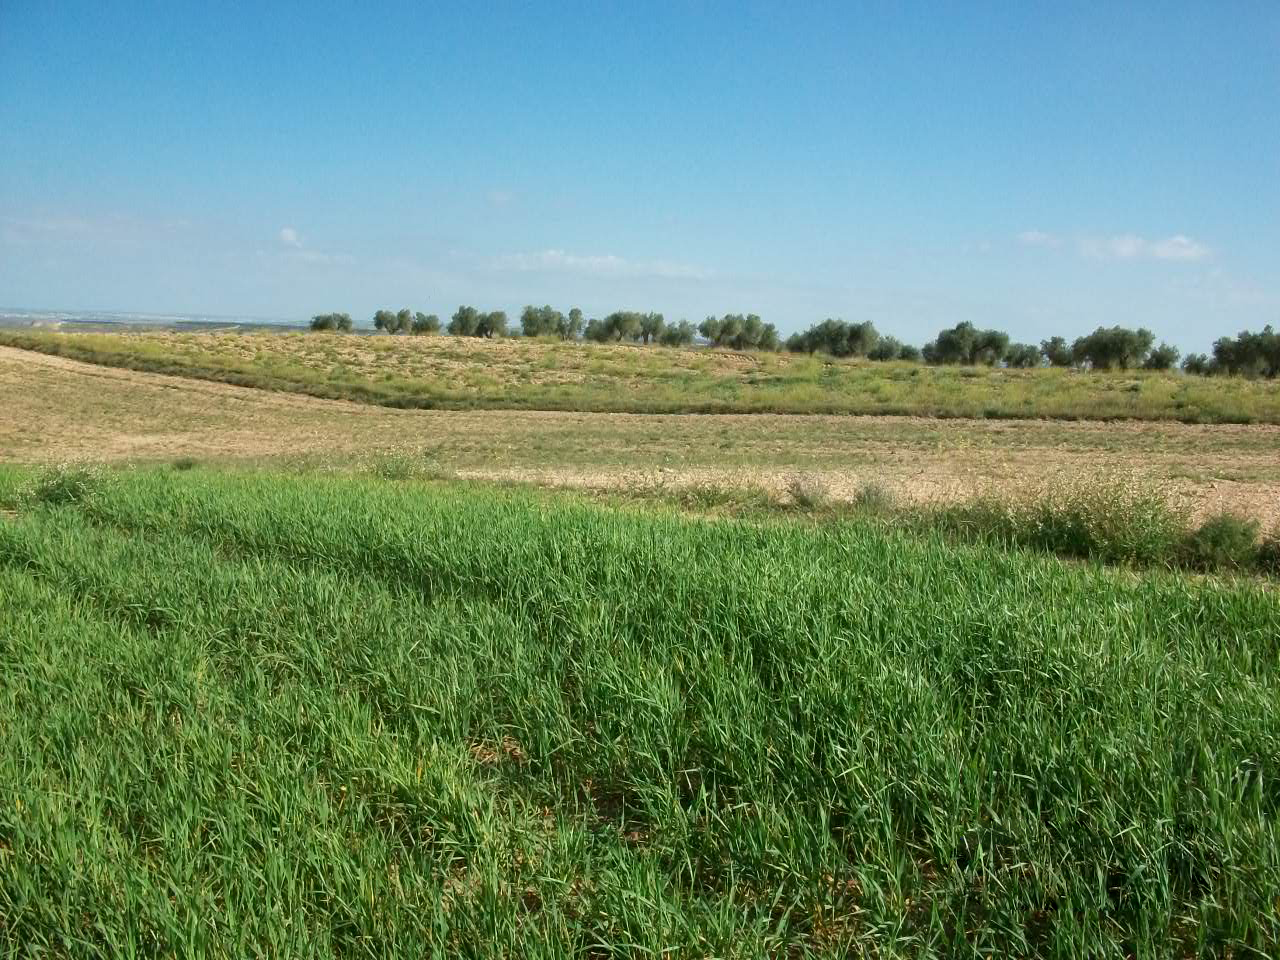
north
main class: Cropland
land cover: Barley
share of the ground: > 75 %
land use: Agriculture (excluding fallow land and kitchen gardens)
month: April
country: ES
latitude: 39.8777
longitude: -3.7698
